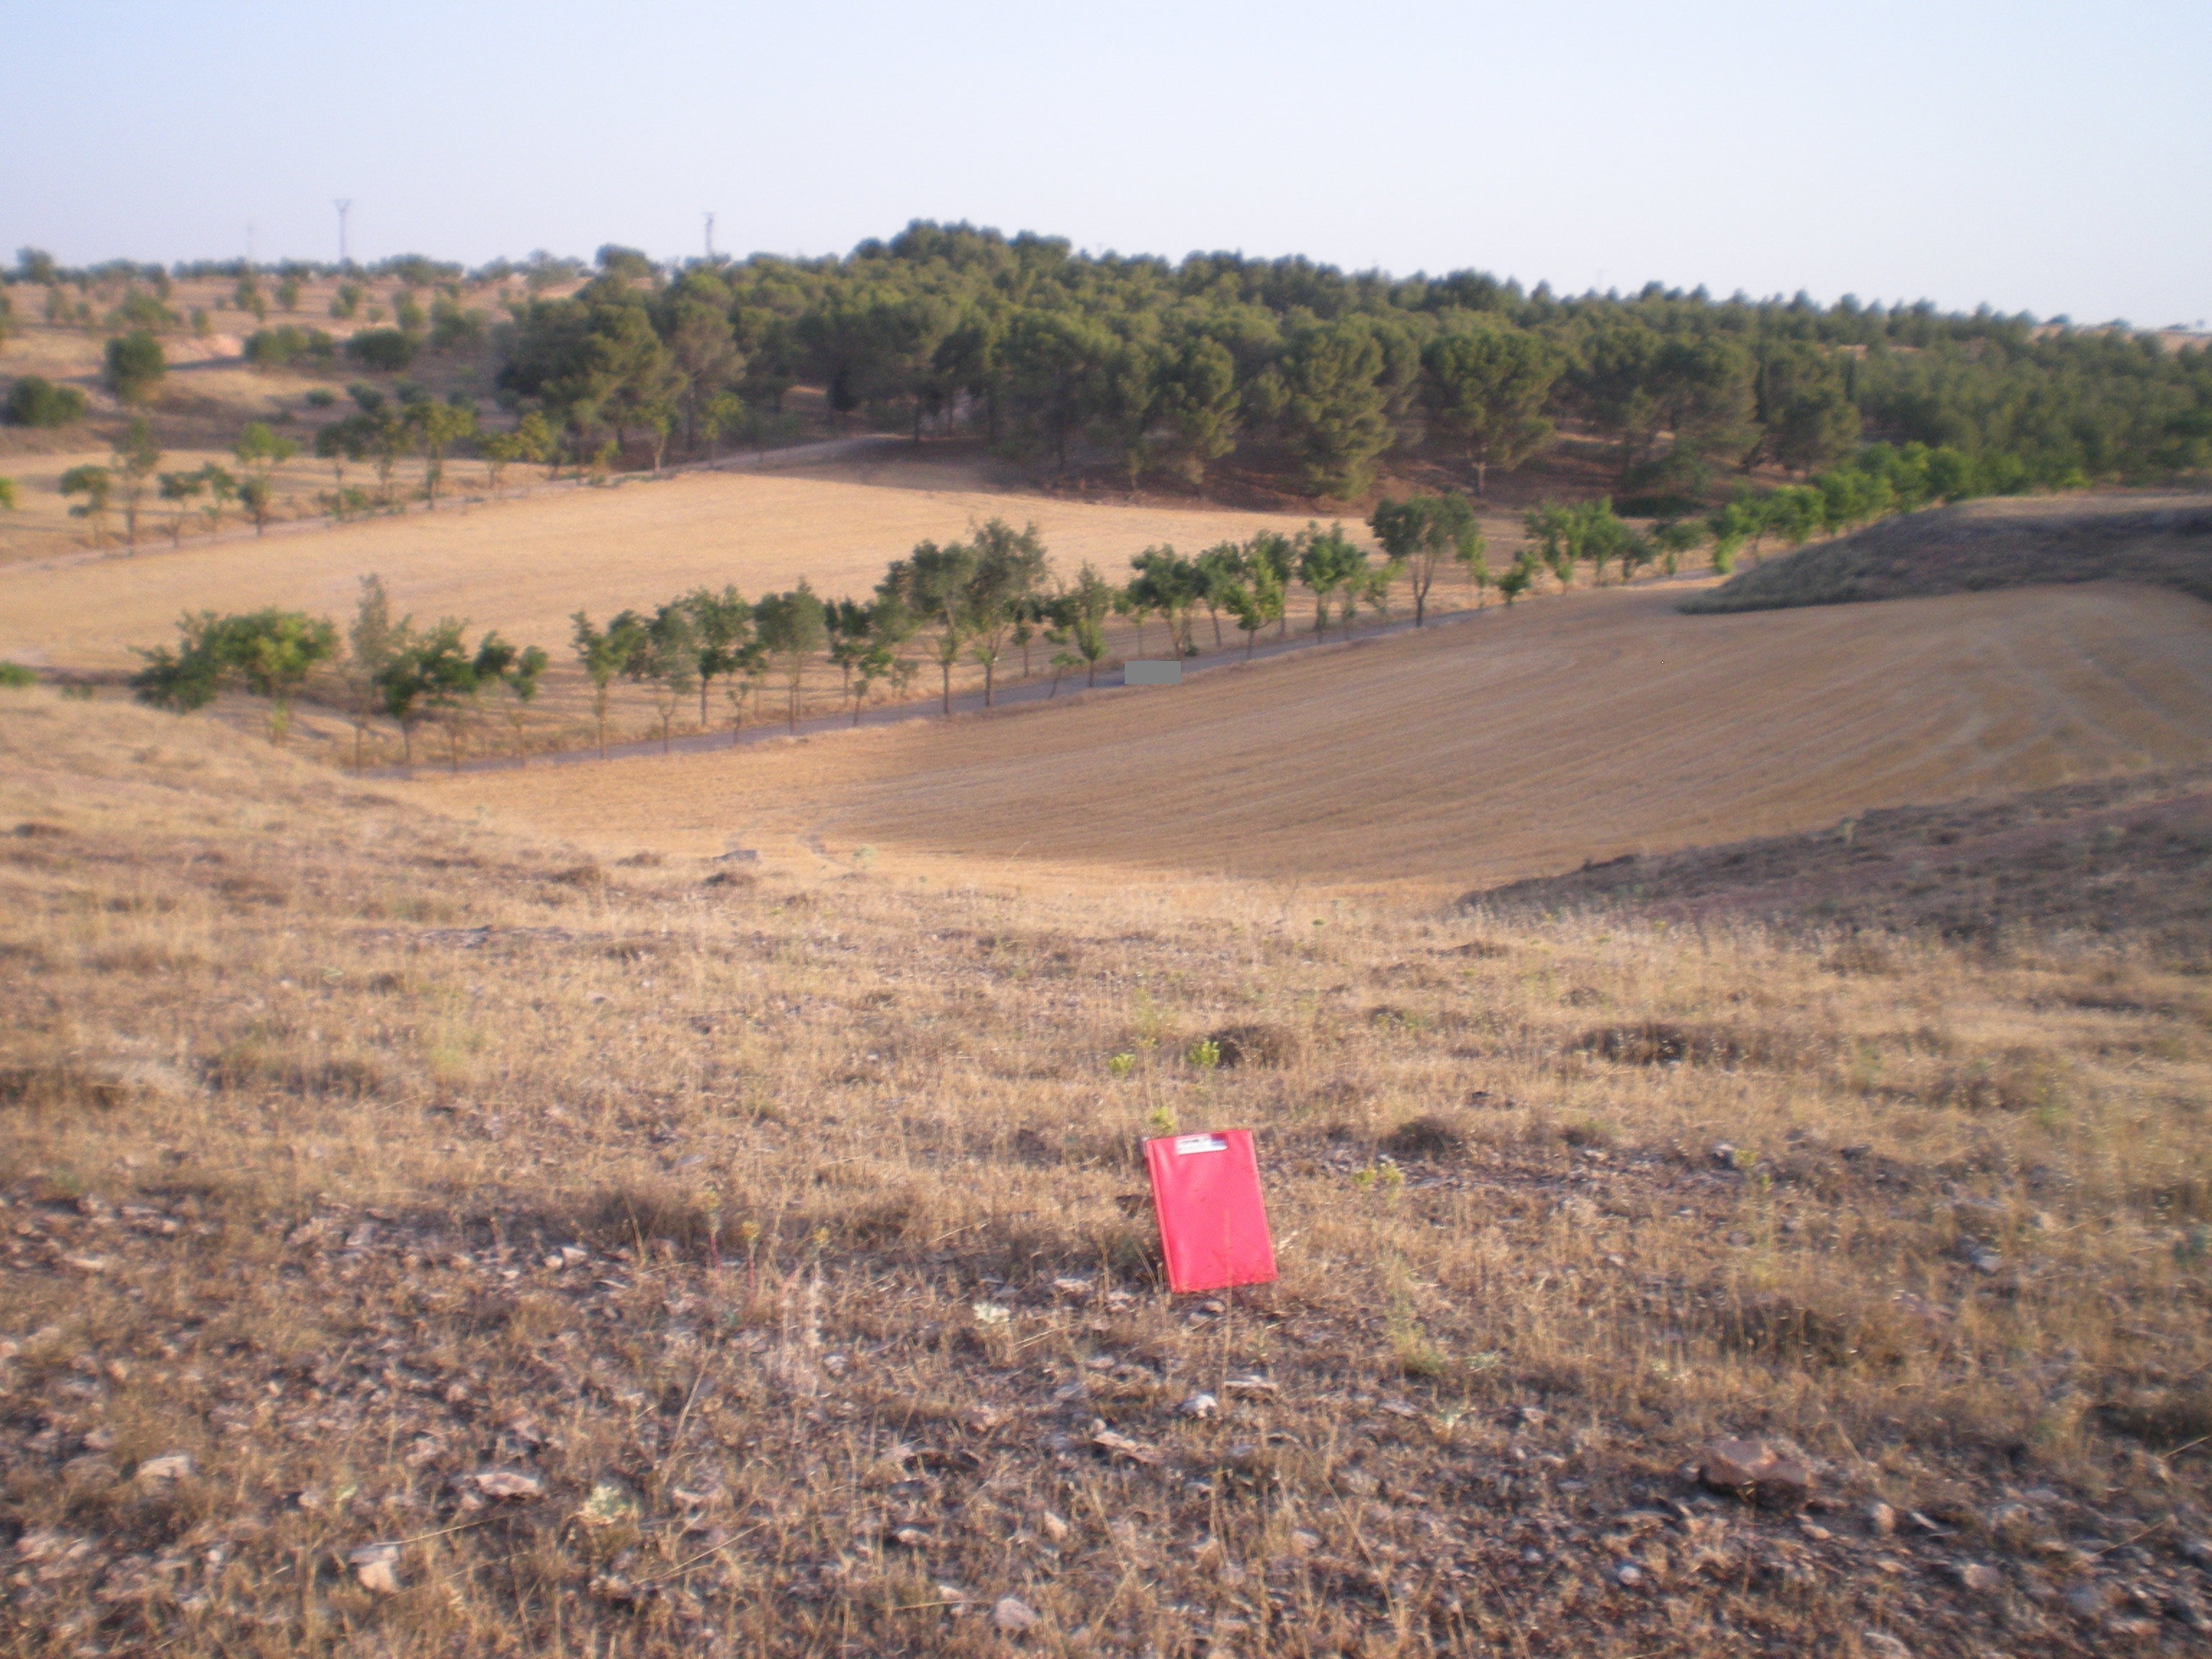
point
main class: Grassland
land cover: Grassland without tree/shrub cover
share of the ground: 25 - 50 %
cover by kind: unconsolidated bare surface 60 %, herbaceous plants 30 %, consolidated bare surface 10 %
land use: Agriculture (excluding fallow land and kitchen gardens)
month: July
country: ES
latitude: 39.4172
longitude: -3.1309
